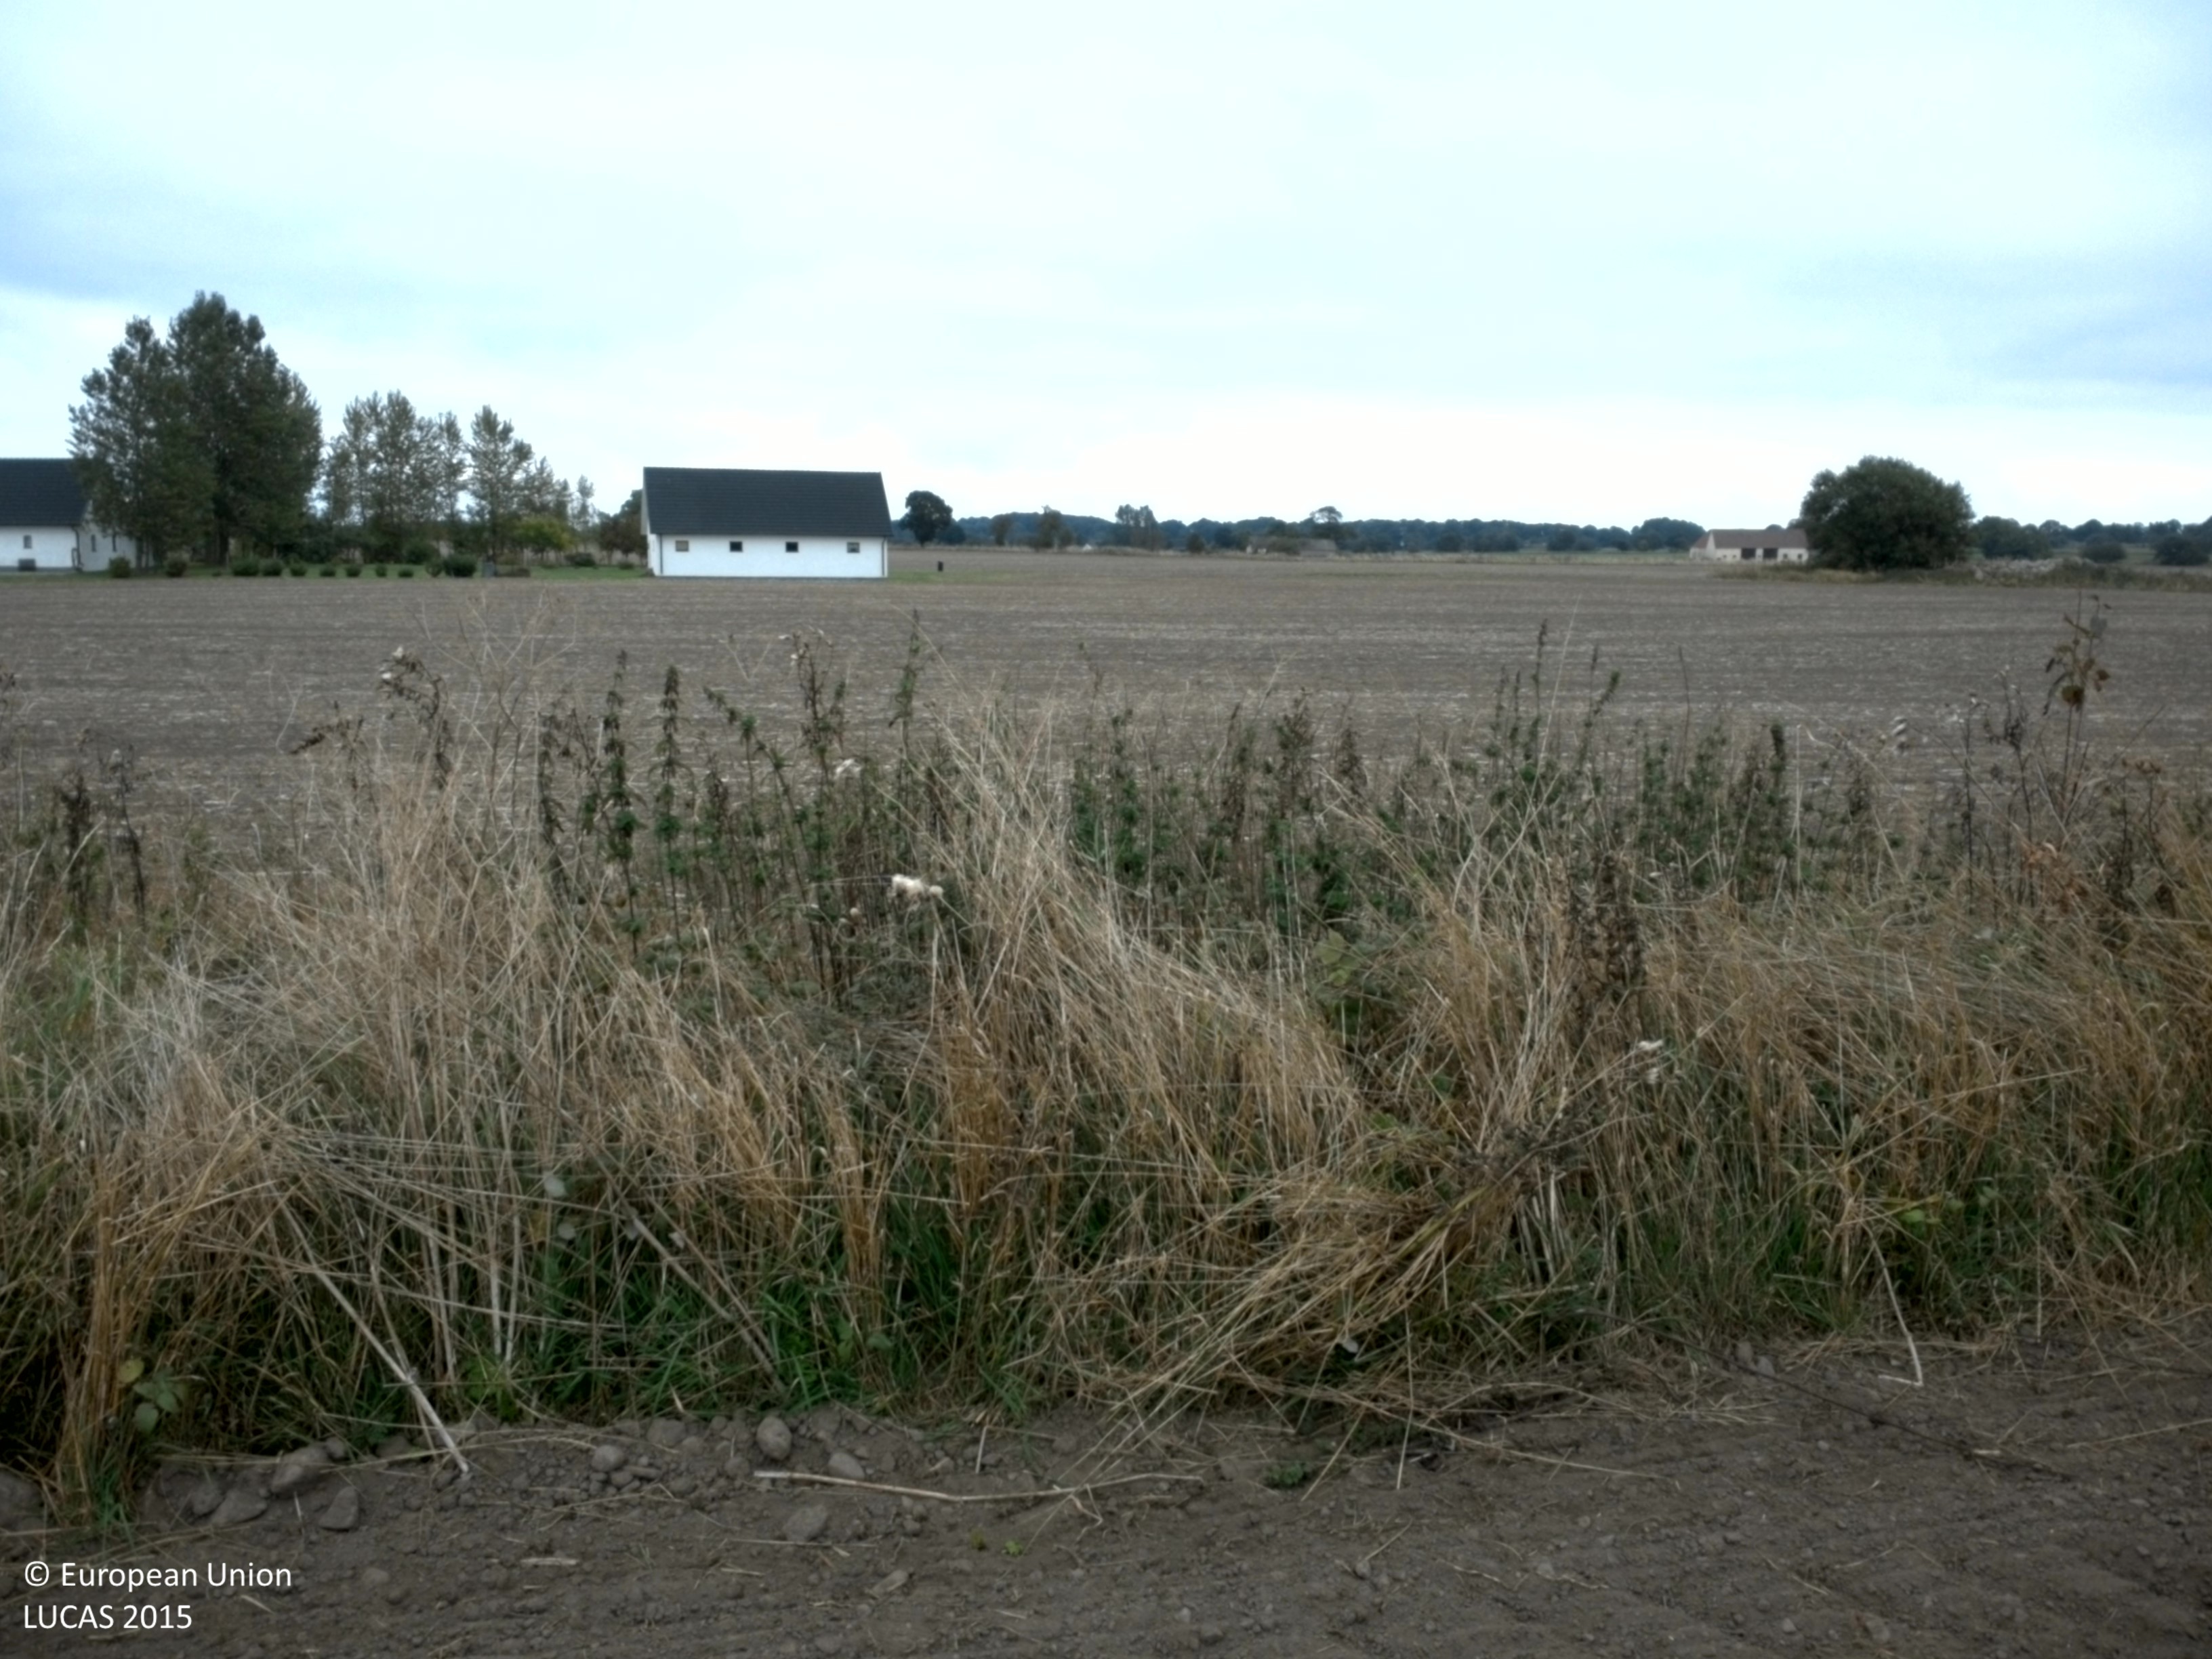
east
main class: Cropland
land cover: Common wheat
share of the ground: < 10 %
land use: Agriculture (excluding fallow land and kitchen gardens)
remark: Tilled/Sowed
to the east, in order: Common wheat; Dry stone walls; Ditches and canals; Common wheat; Paved roads, cycling and walking lanes; Common wheat
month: October
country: SE
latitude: 55.5662
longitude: 14.0421
